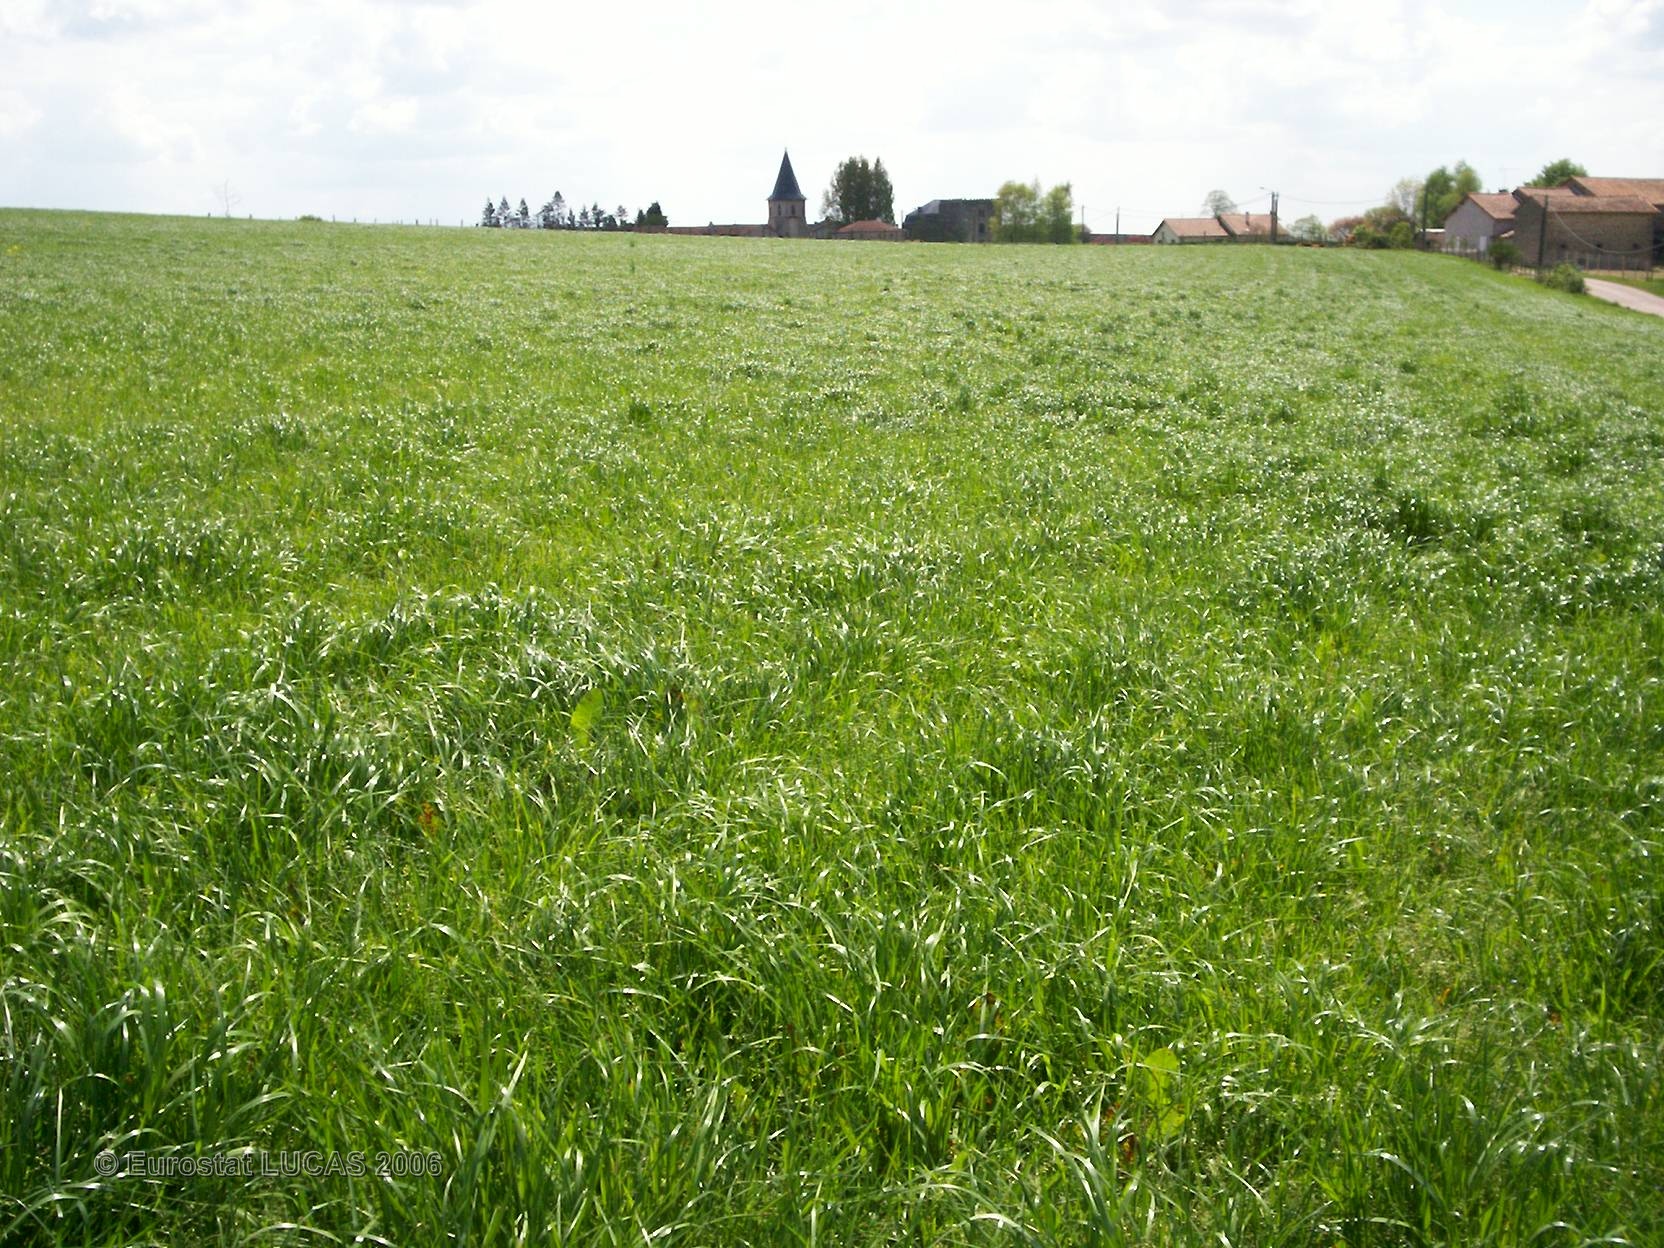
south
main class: Grassland
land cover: Grassland without tree/shrub cover
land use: Agriculture (excluding fallow land and kitchen gardens)
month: April
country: FR
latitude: 45.6761
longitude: 0.7319
